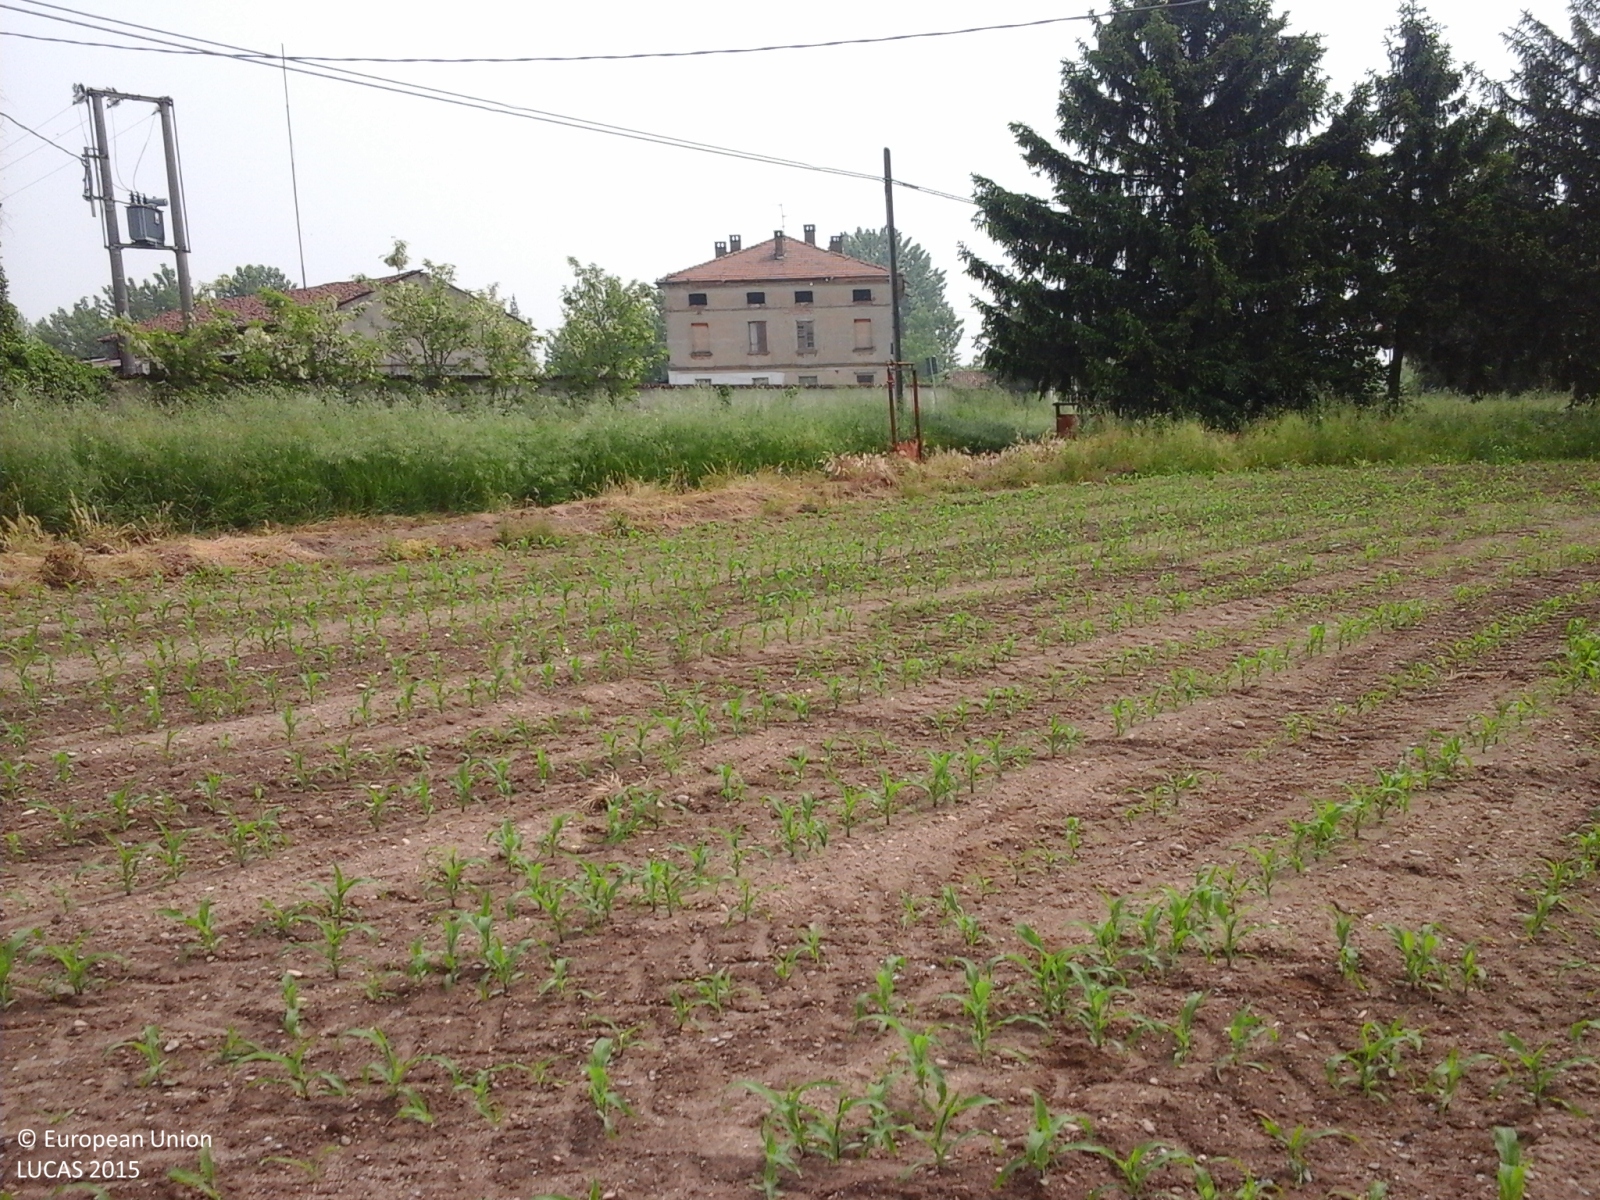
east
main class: Cropland
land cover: Maize
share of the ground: 10 - 25 %
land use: Agriculture (excluding fallow land and kitchen gardens)
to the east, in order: Maize; Electric lines; Grass margins; Ditches and canals; Spontaneously vegetated surfaces; Electric lines; Spontaneously vegetated surfaces; Artificial constructions in urban areas; Abandoned hedges; Inland fresh running water; Broadleaved woodland; Artificial constructions in urban areas; Lucerne
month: May
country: IT
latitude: 45.3421
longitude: 9.8599
